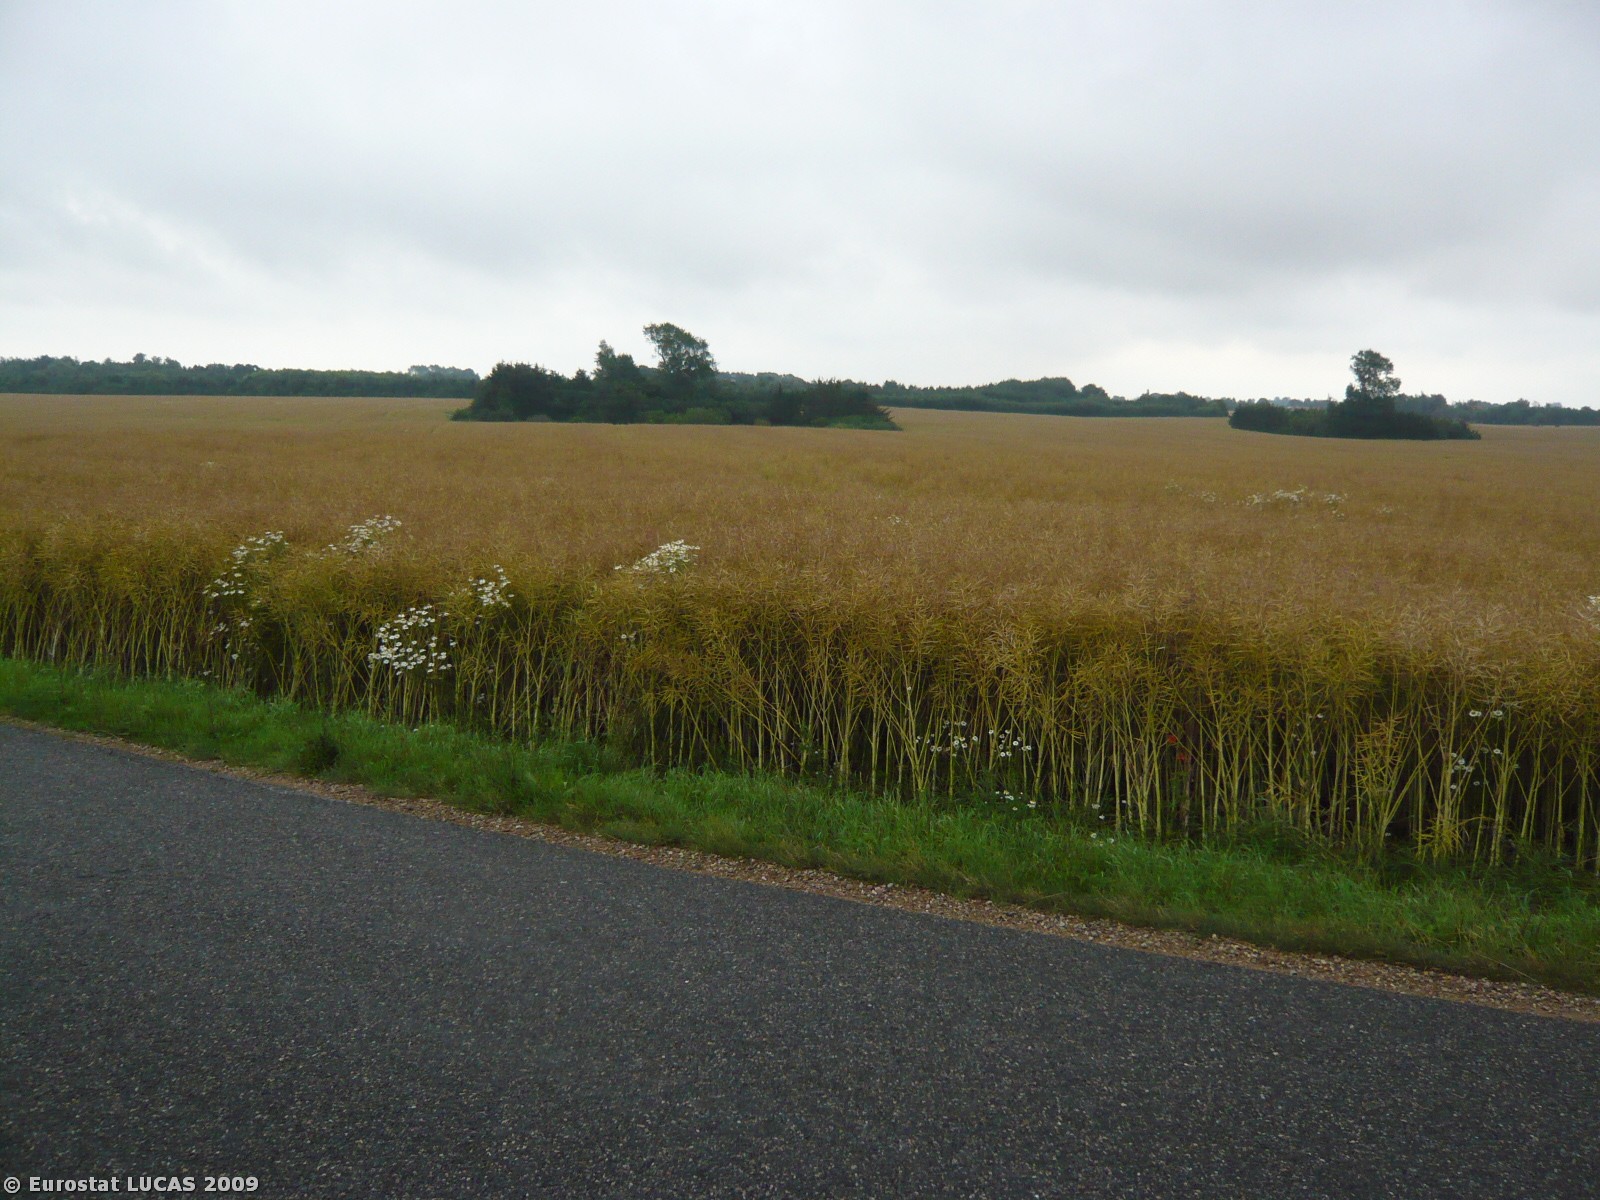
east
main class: Cropland
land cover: Common wheat
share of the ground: > 75 %
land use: Agriculture (excluding fallow land and kitchen gardens)
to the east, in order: Common wheat; Barley; Grass margins; Fences; Common wheat
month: July
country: DK
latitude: 55.6884
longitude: 11.8912
